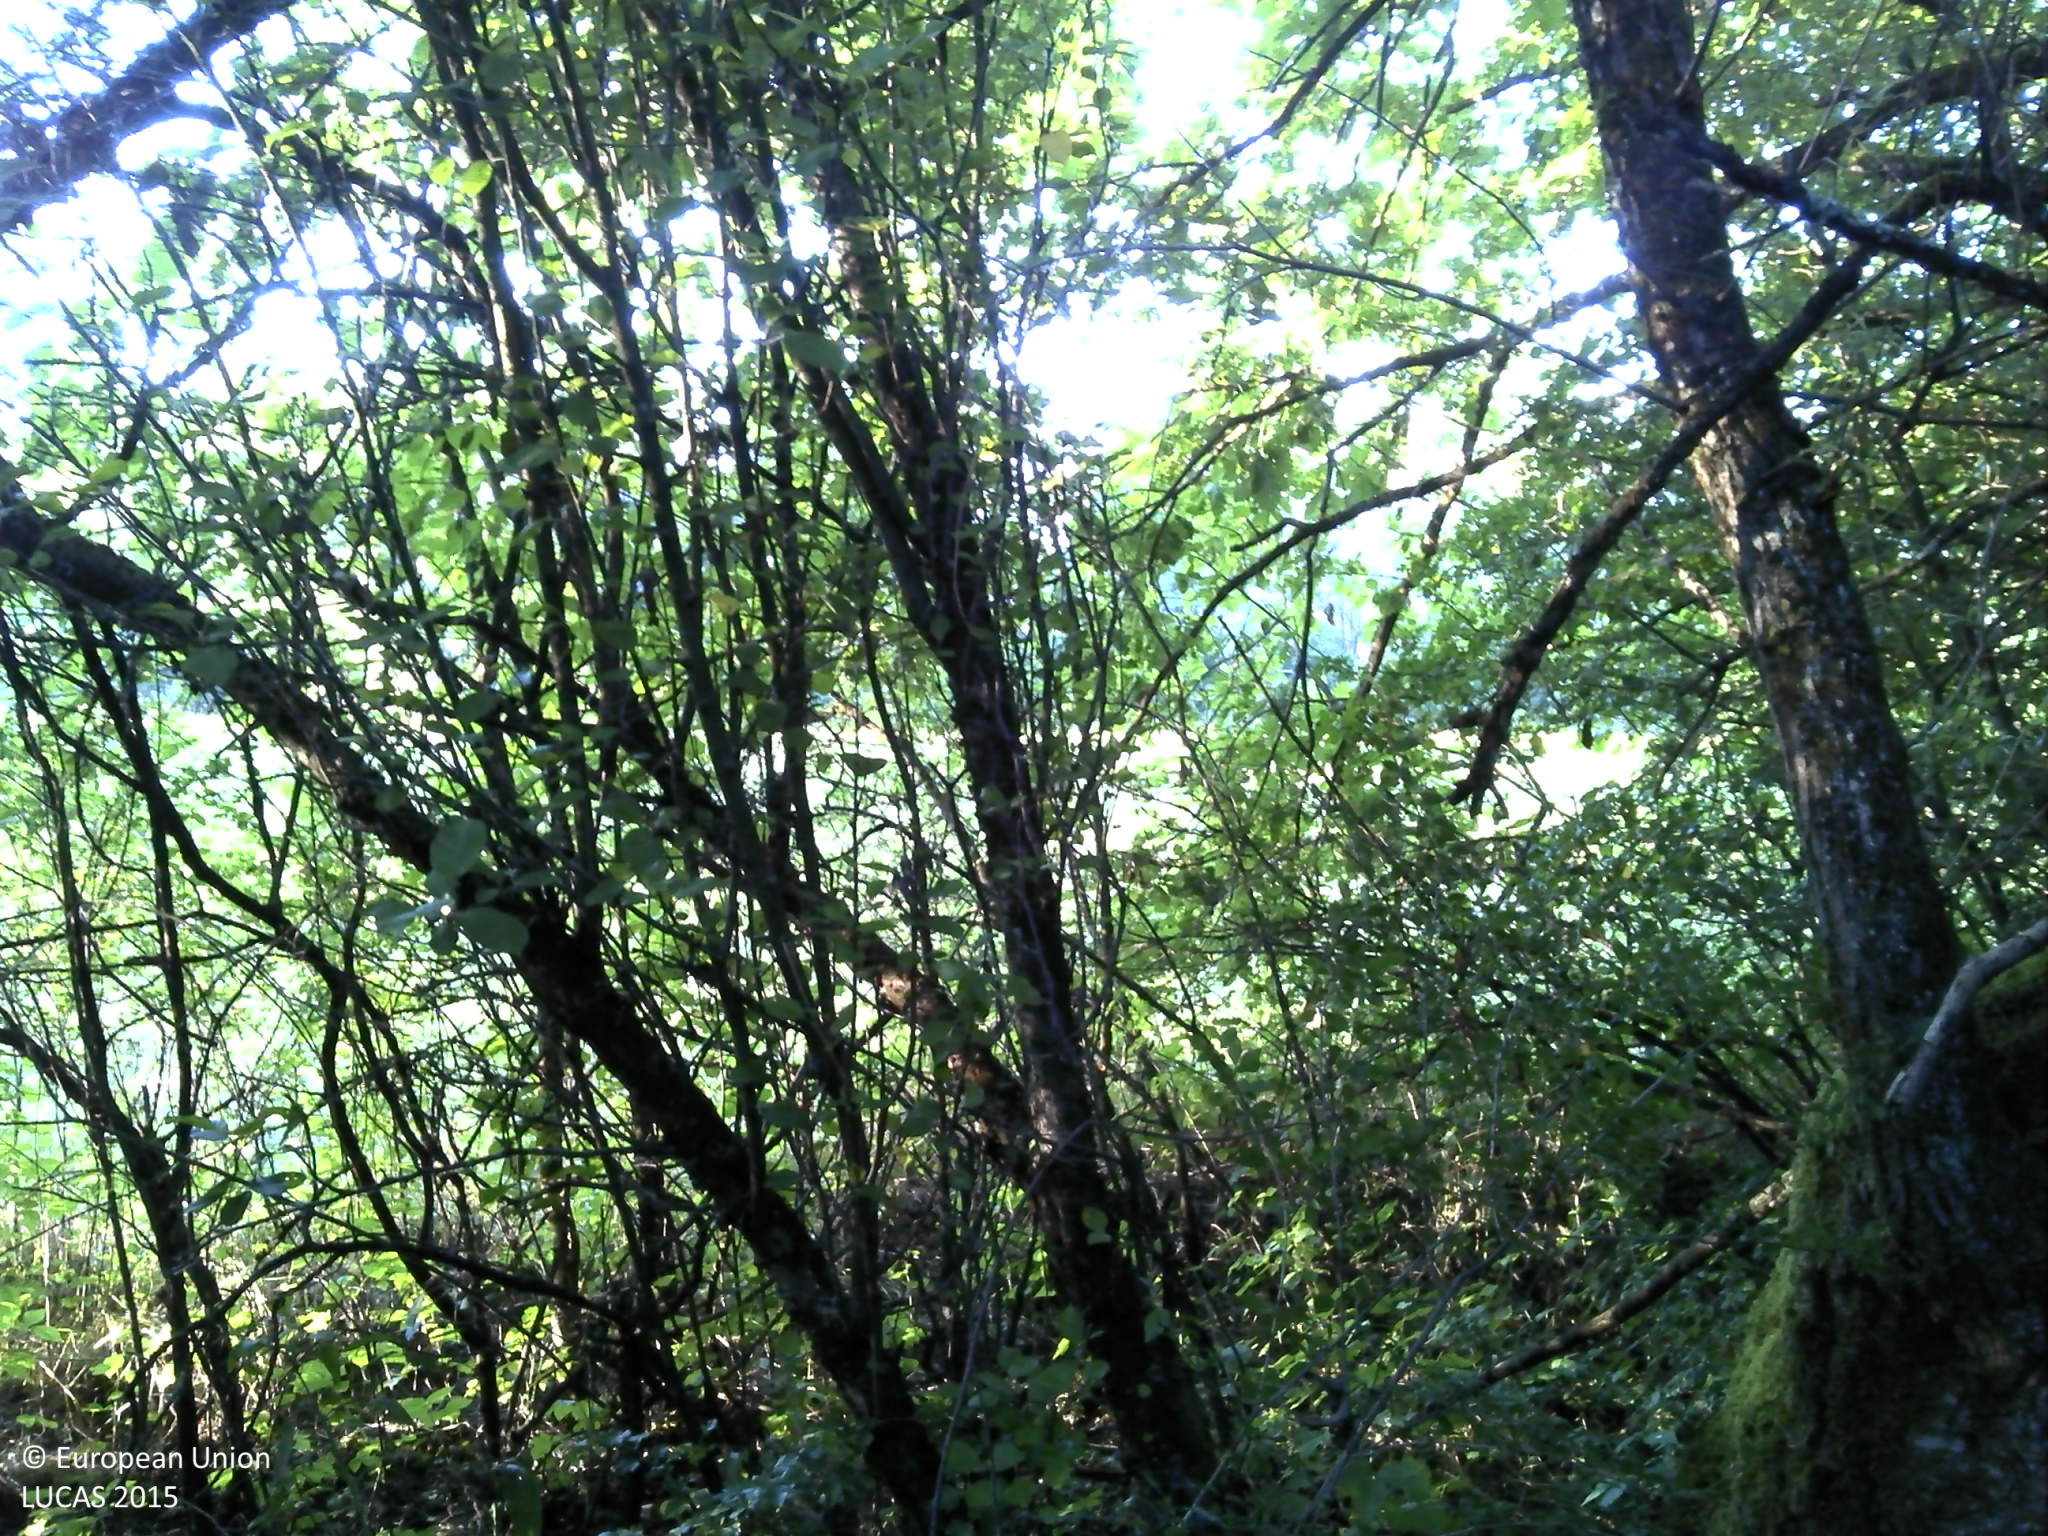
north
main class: Shrubland
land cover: Shrubland with sparse tree cover
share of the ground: > 75 %
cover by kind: shrubs 95 %, broadleaved forest trees 5 %
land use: Semi-natural and natural areas not in use
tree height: < 5 m
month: July
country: HR
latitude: 45.3915
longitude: 16.8324
